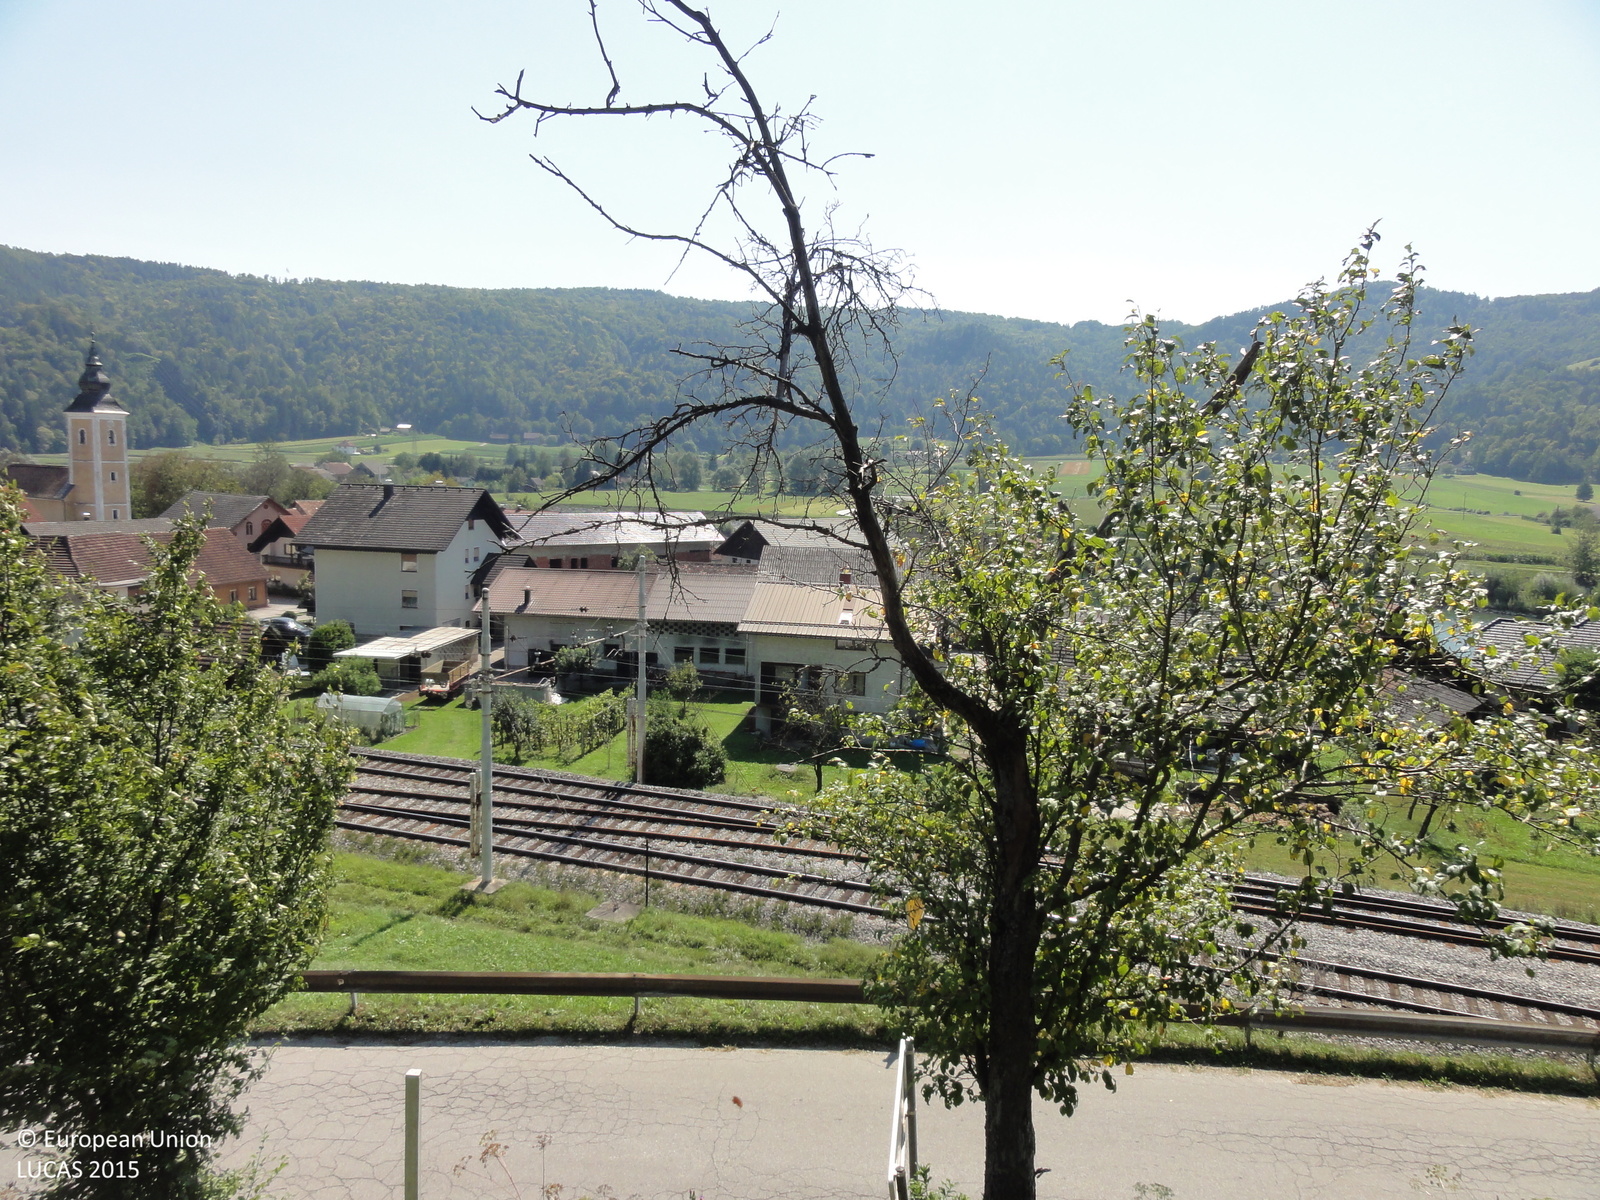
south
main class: Cropland
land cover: Apple fruit
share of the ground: 25 - 50 %
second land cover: Grassland without tree/shrub cover
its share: > 75 %
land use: Agriculture (excluding fallow land and kitchen gardens)
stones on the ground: < 10 %
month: September
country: SI
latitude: 46.0428
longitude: 15.2308
